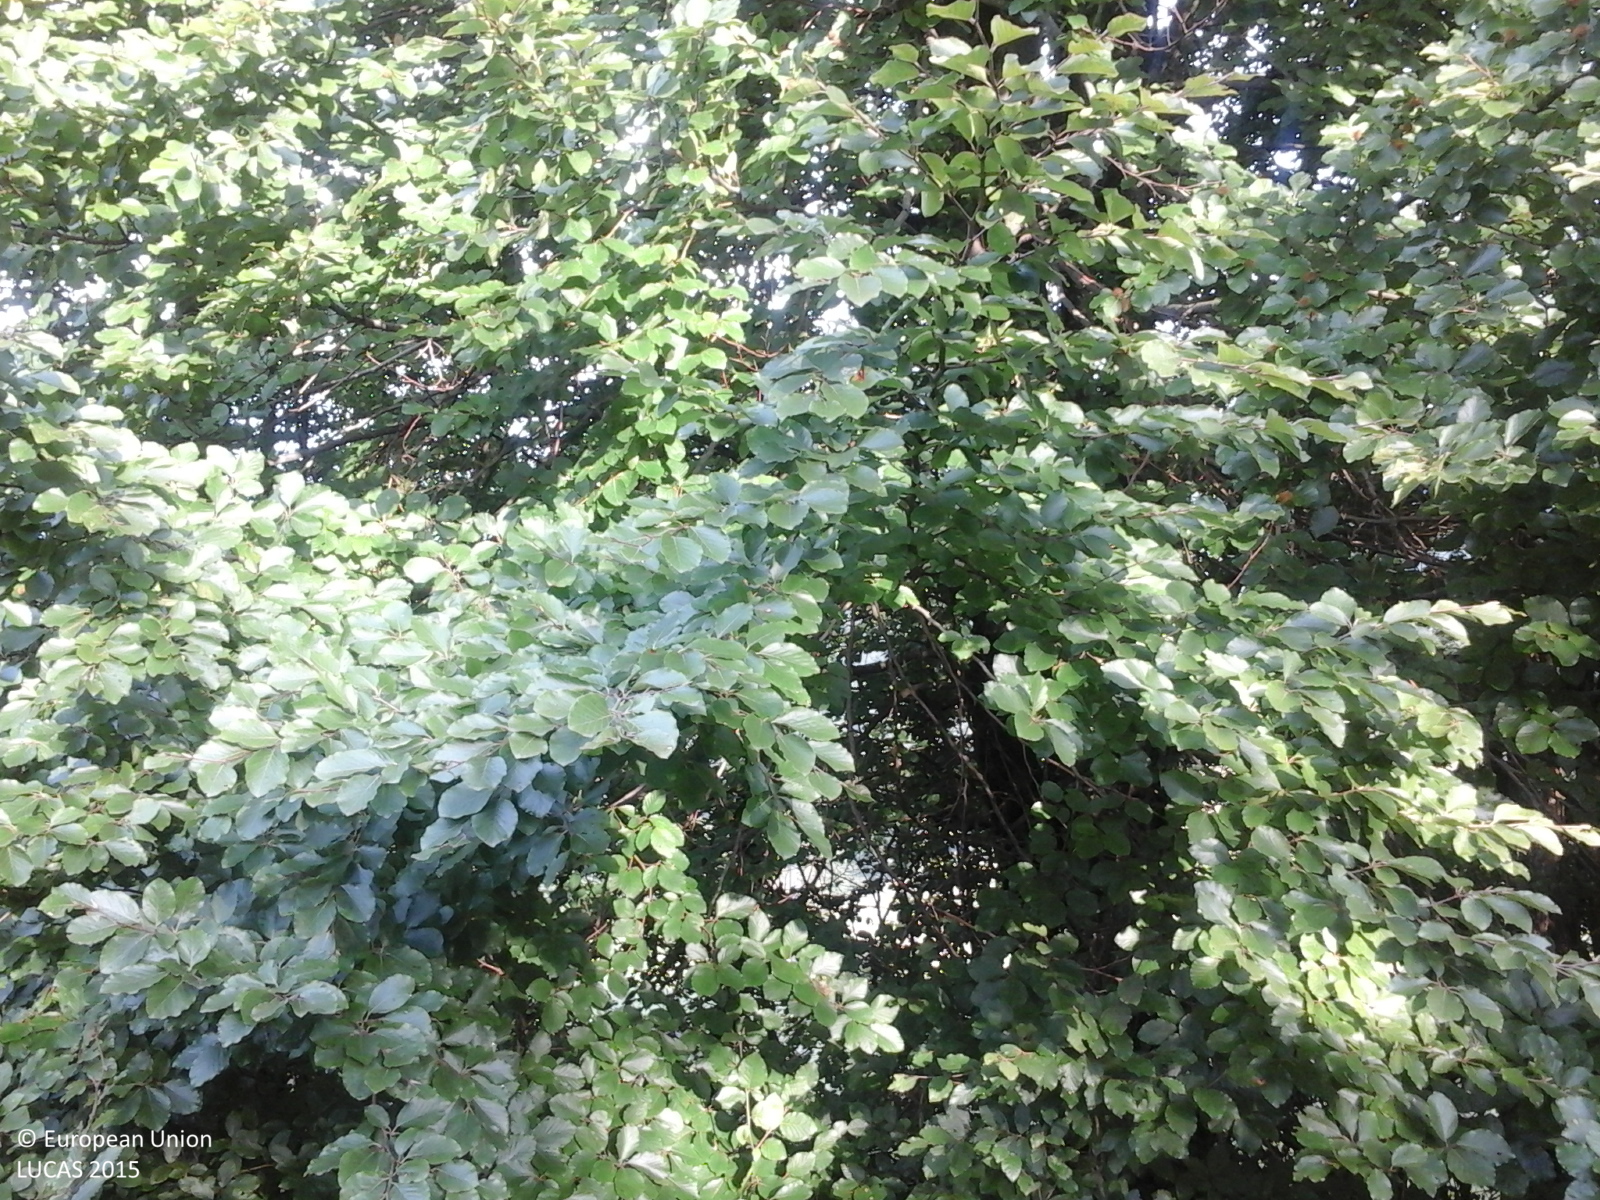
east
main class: Woodland
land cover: Broadleaved woodland
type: mesophytic deciduous forest
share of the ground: > 75 %
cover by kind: broadleaved forest trees 100 %
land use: Forestry
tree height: > 5 m
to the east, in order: Broadleaved woodland; Electric lines; Broadleaved woodland; Grassland with sparse tree/shrub cover; Fences; Grassland without tree/shrub cover; Fences; Grassland without tree/shrub cover; Broadleaved woodland
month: September
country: RO
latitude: 46.9089
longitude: 22.6466
